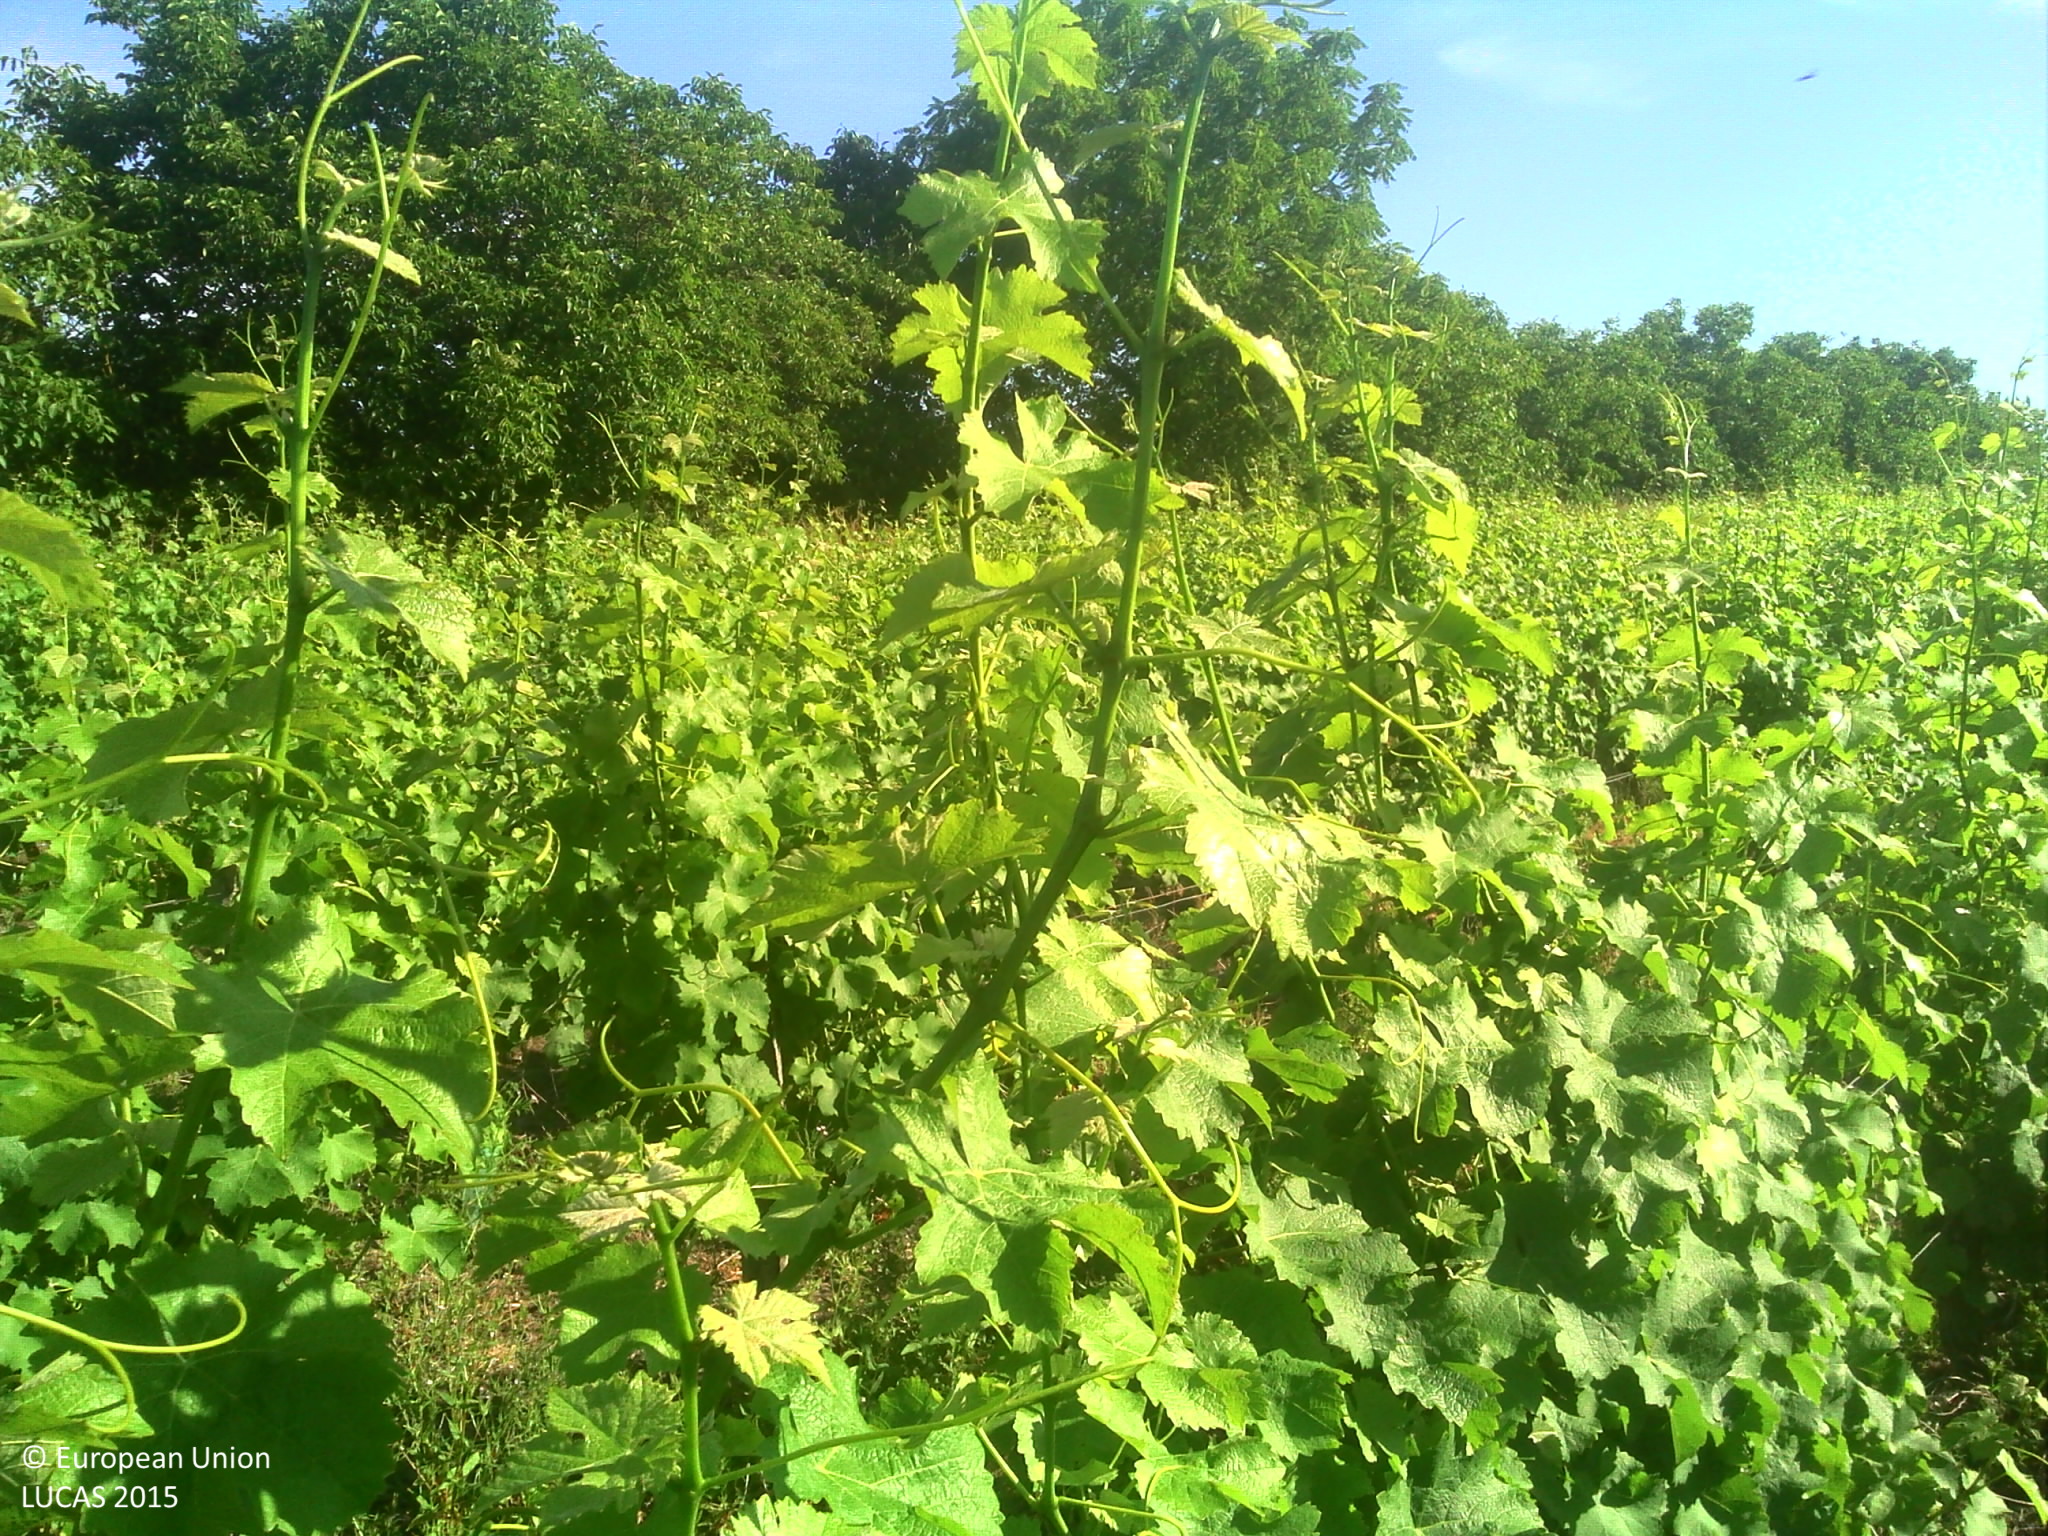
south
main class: Cropland
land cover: Vineyards
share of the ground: 25 - 50 %
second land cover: Other bare soil
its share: > 75 %
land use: Agriculture (excluding fallow land and kitchen gardens)
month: June
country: FR
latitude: 47.2764
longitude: 1.4602
